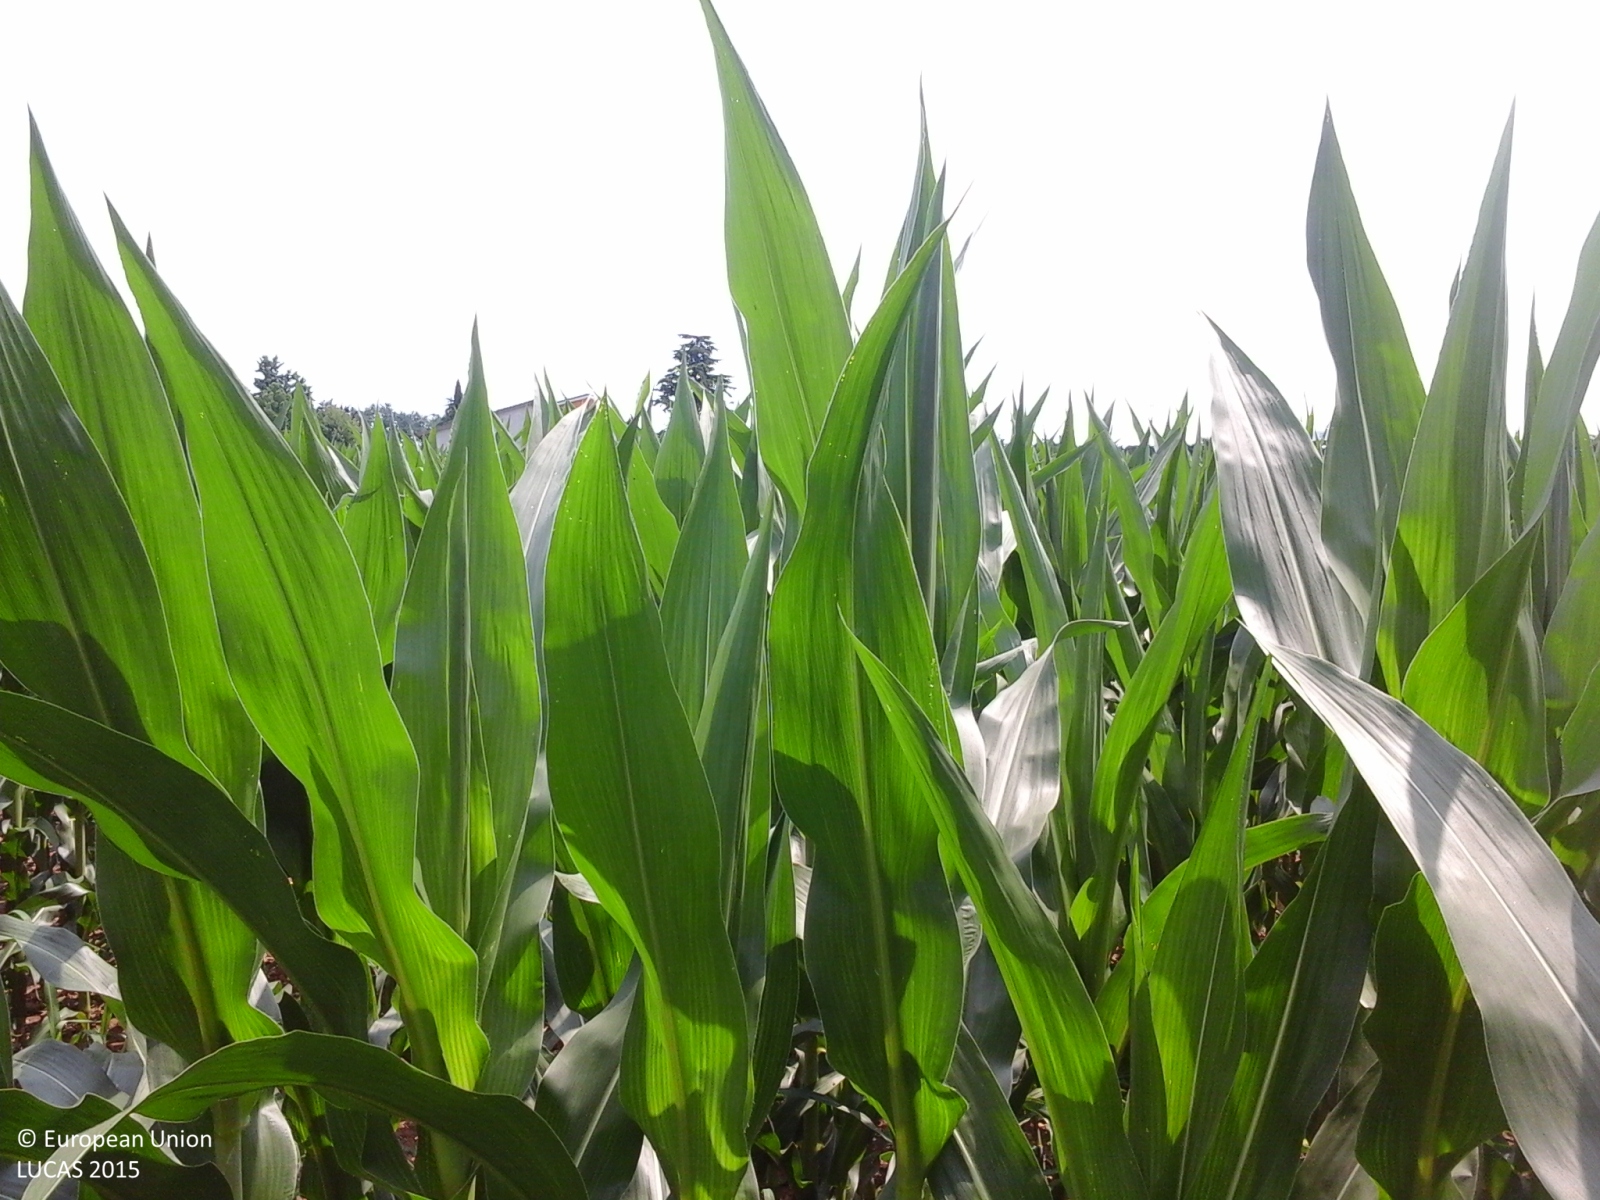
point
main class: Cropland
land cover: Maize
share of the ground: > 75 %
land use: Agriculture (excluding fallow land and kitchen gardens)
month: June
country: IT
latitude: 45.4106
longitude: 10.8801
